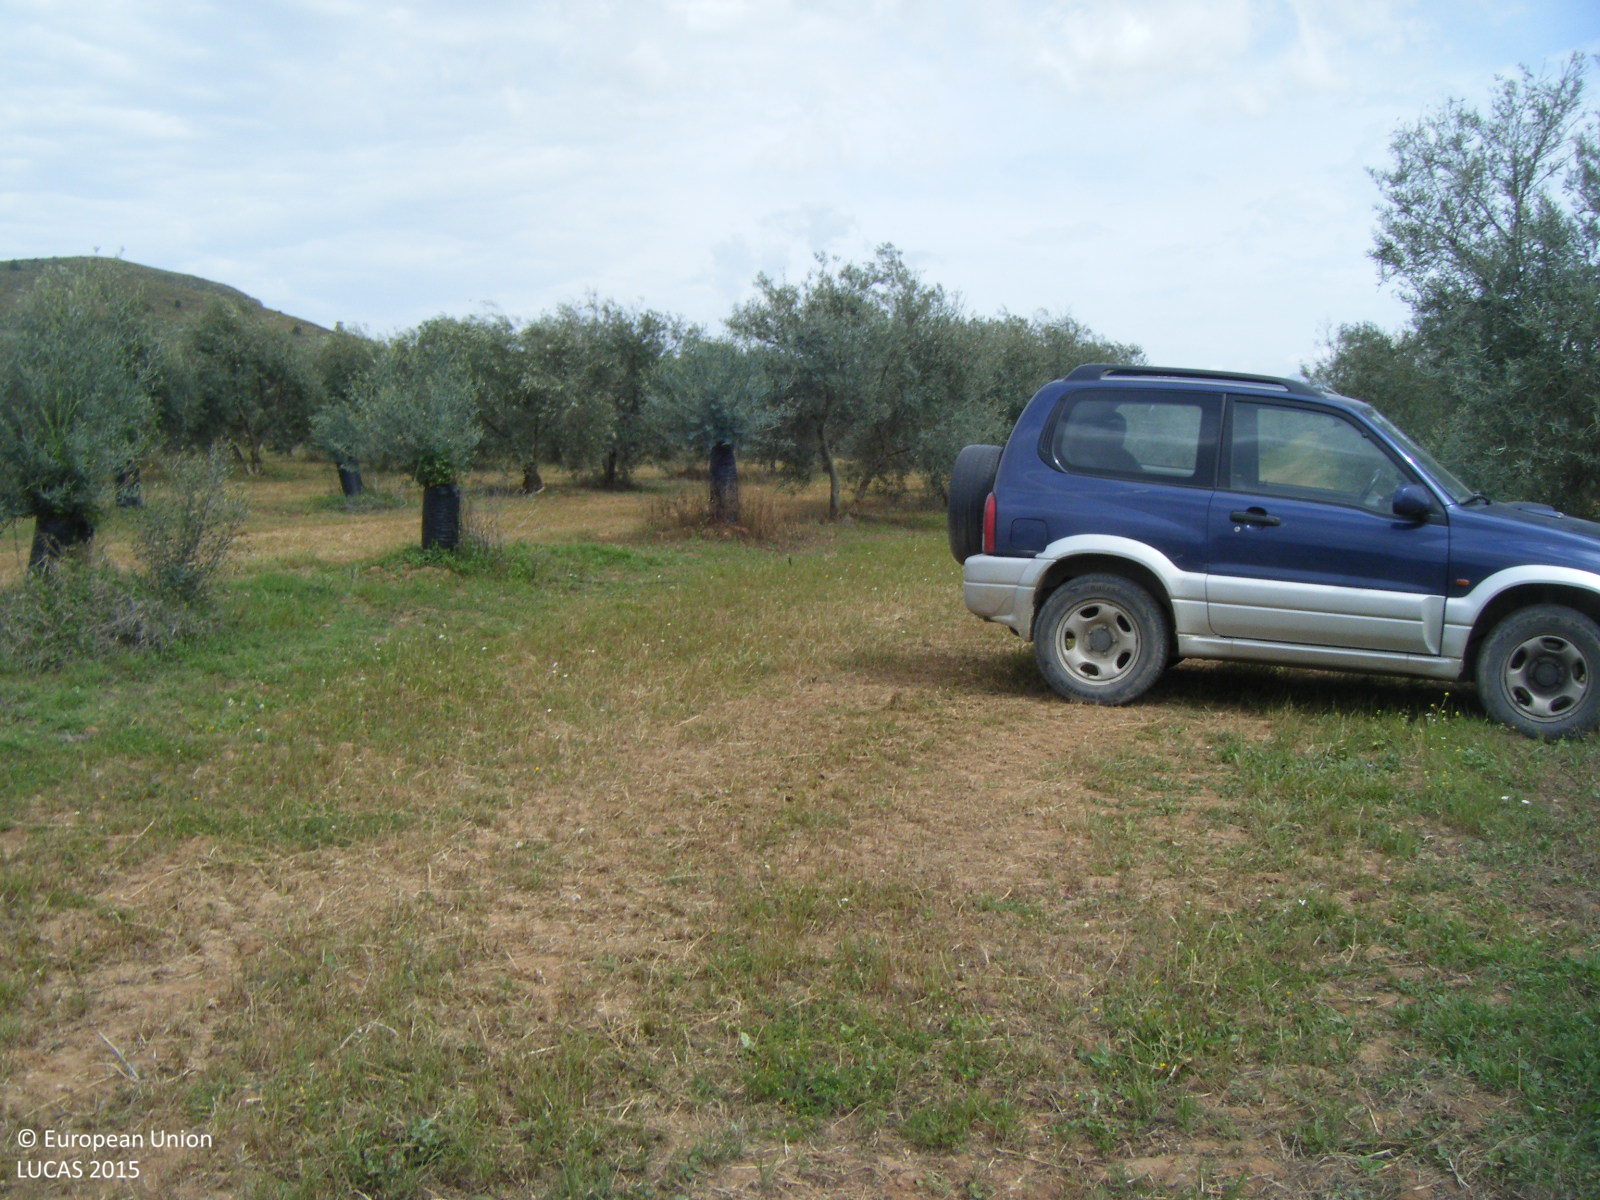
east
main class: Grassland
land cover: Grassland without tree/shrub cover
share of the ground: > 75 %
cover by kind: herbaceous plants 100 %
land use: Semi-natural and natural areas not in use
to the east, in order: Grassland without tree/shrub cover; Olive groves; Tracks; Grass margins; Spontaneously vegetated surfaces; Tracks; Olive groves
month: April
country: ES
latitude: 37.0306
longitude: -4.7594
